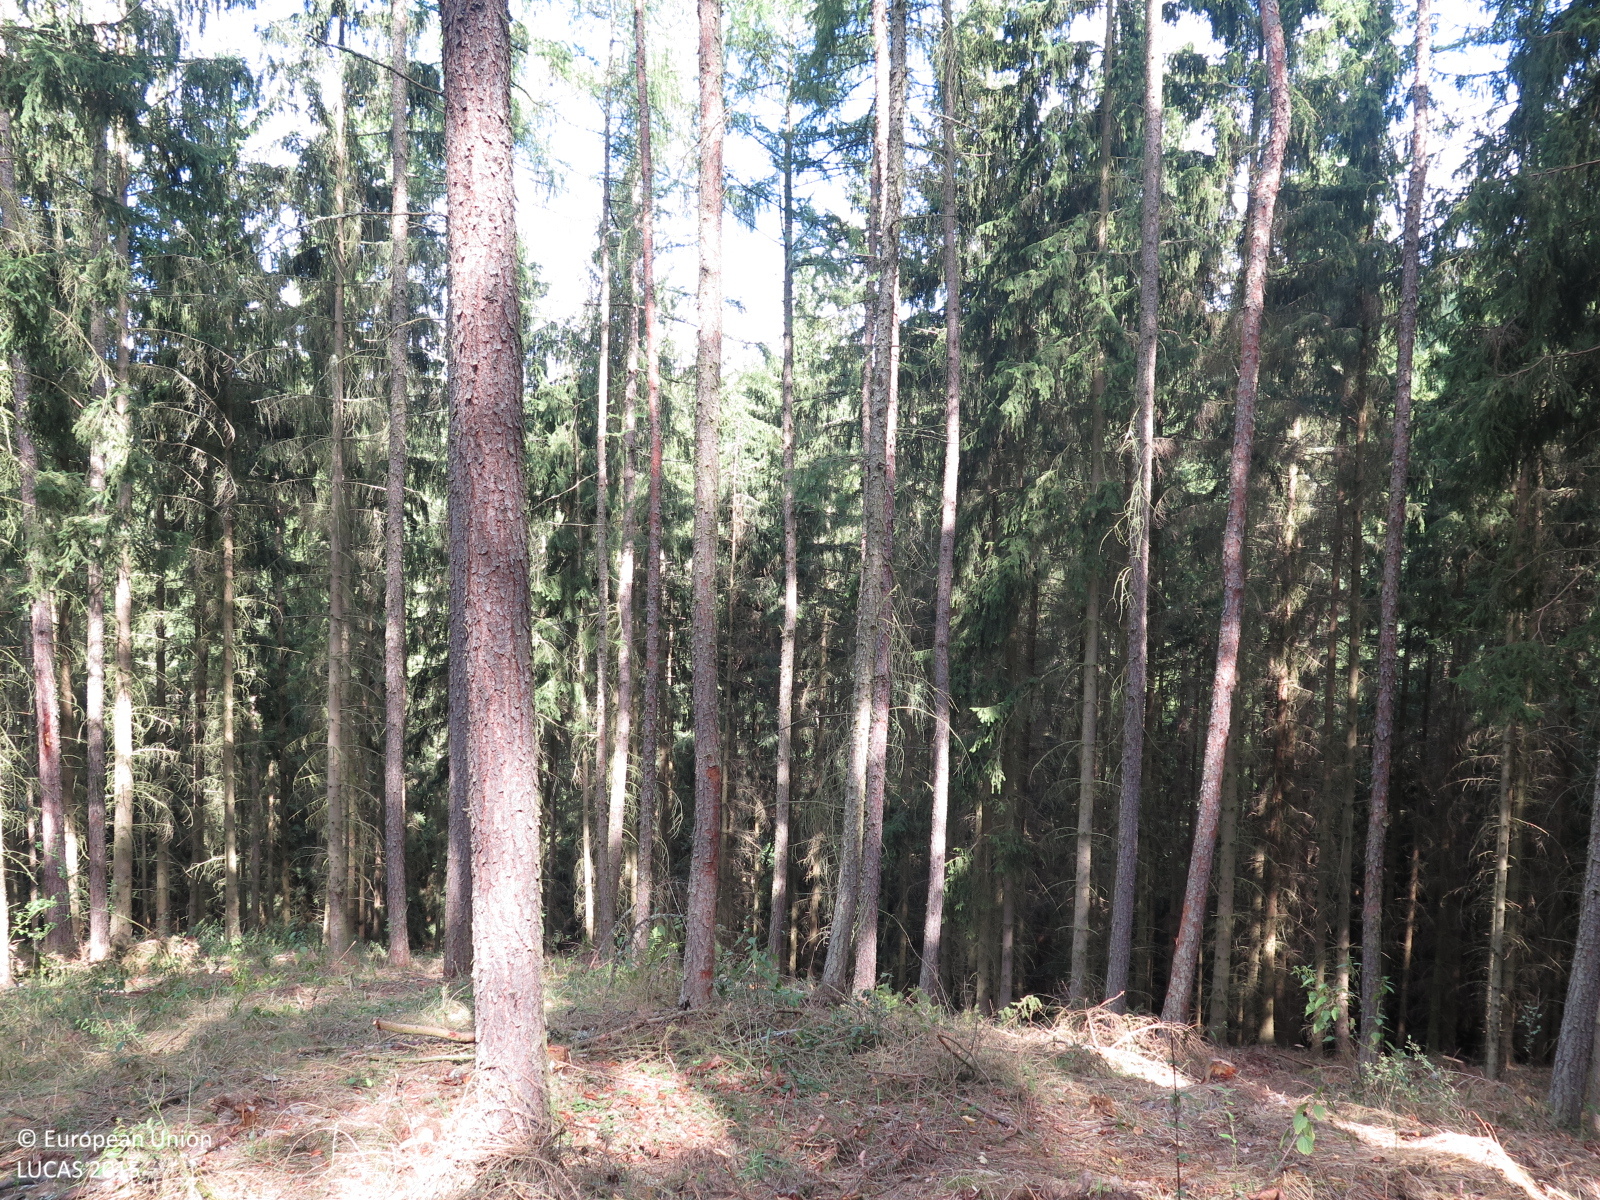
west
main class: Woodland
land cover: Other coniferous woodland
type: hemiboreal forest and nemoral coniferous forest and mixed broadleaved-coniferous forest
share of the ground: > 75 %
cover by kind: coniferous forest trees 90 %, shrubs 5 %, herbaceous plants 5 %
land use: Forestry
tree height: > 5 m
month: August
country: CZ
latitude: 50.0665
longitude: 13.8146
